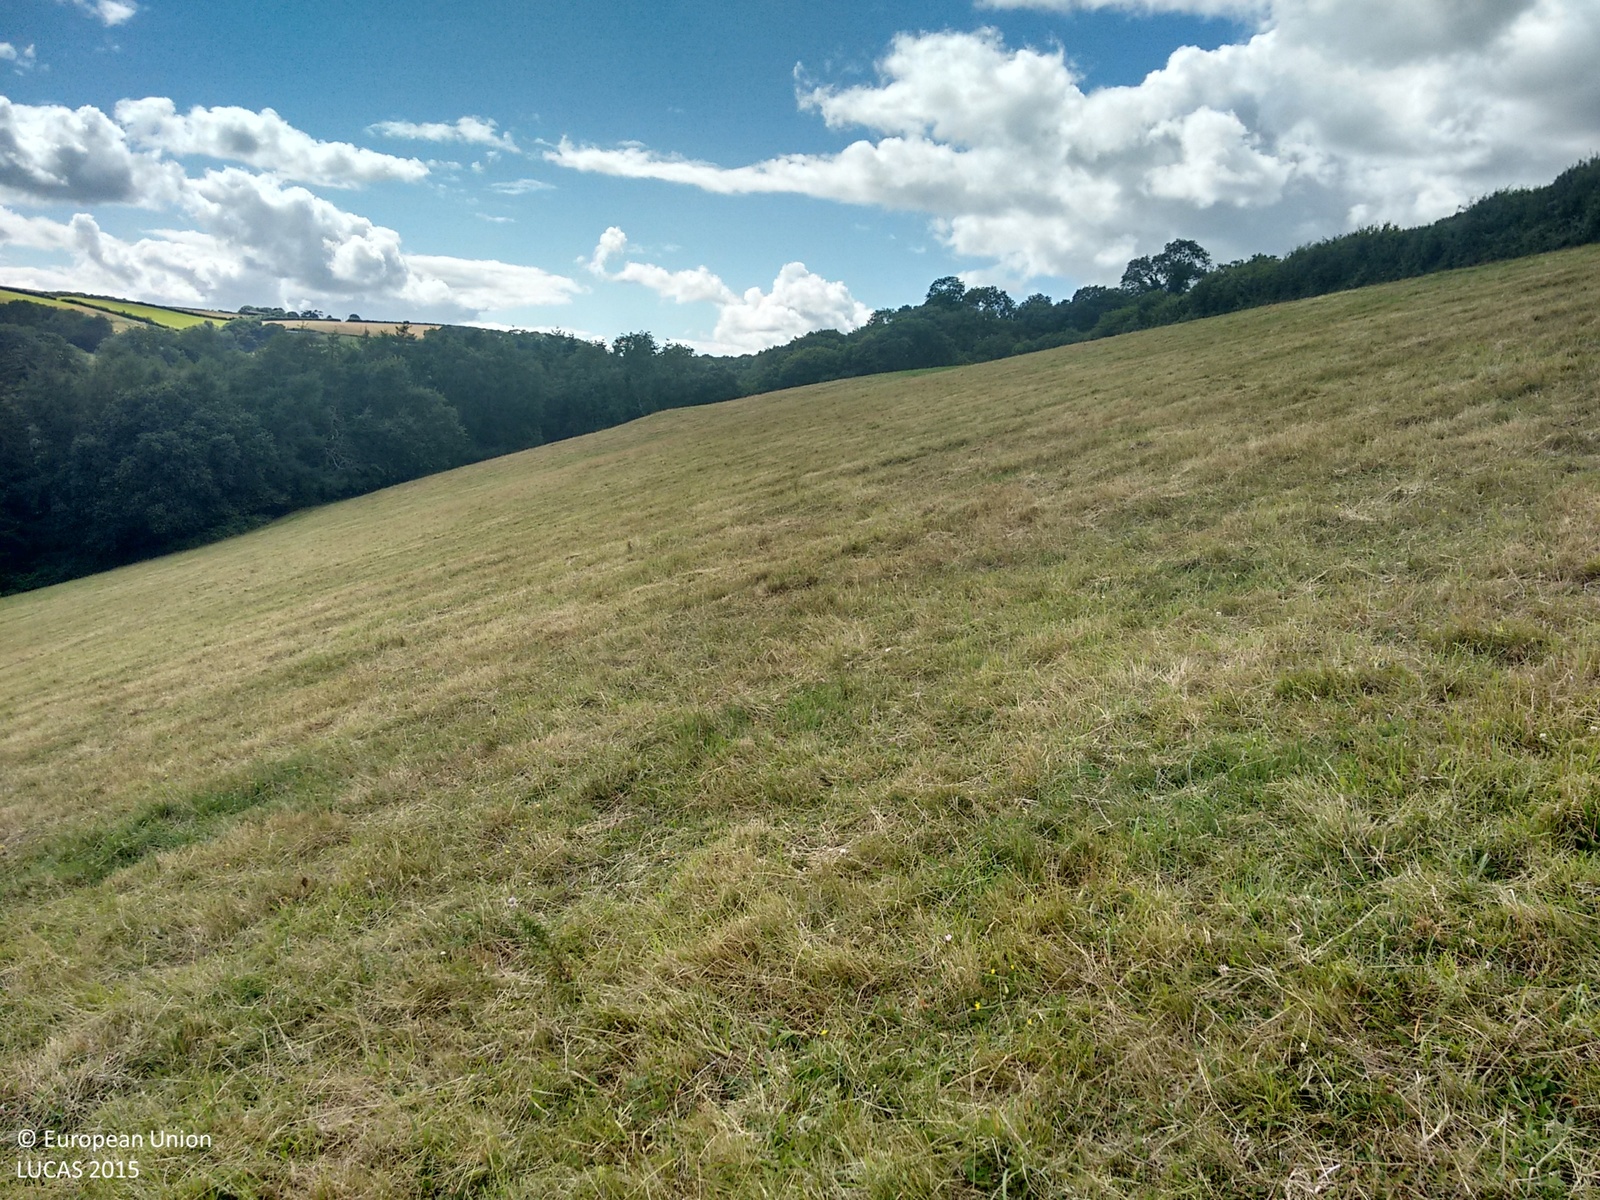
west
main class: Grassland
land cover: Grassland without tree/shrub cover
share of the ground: > 75 %
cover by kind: herbaceous plants 100 %
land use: Agriculture (excluding fallow land and kitchen gardens)
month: July
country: GB
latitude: 50.3825
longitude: -3.6290
